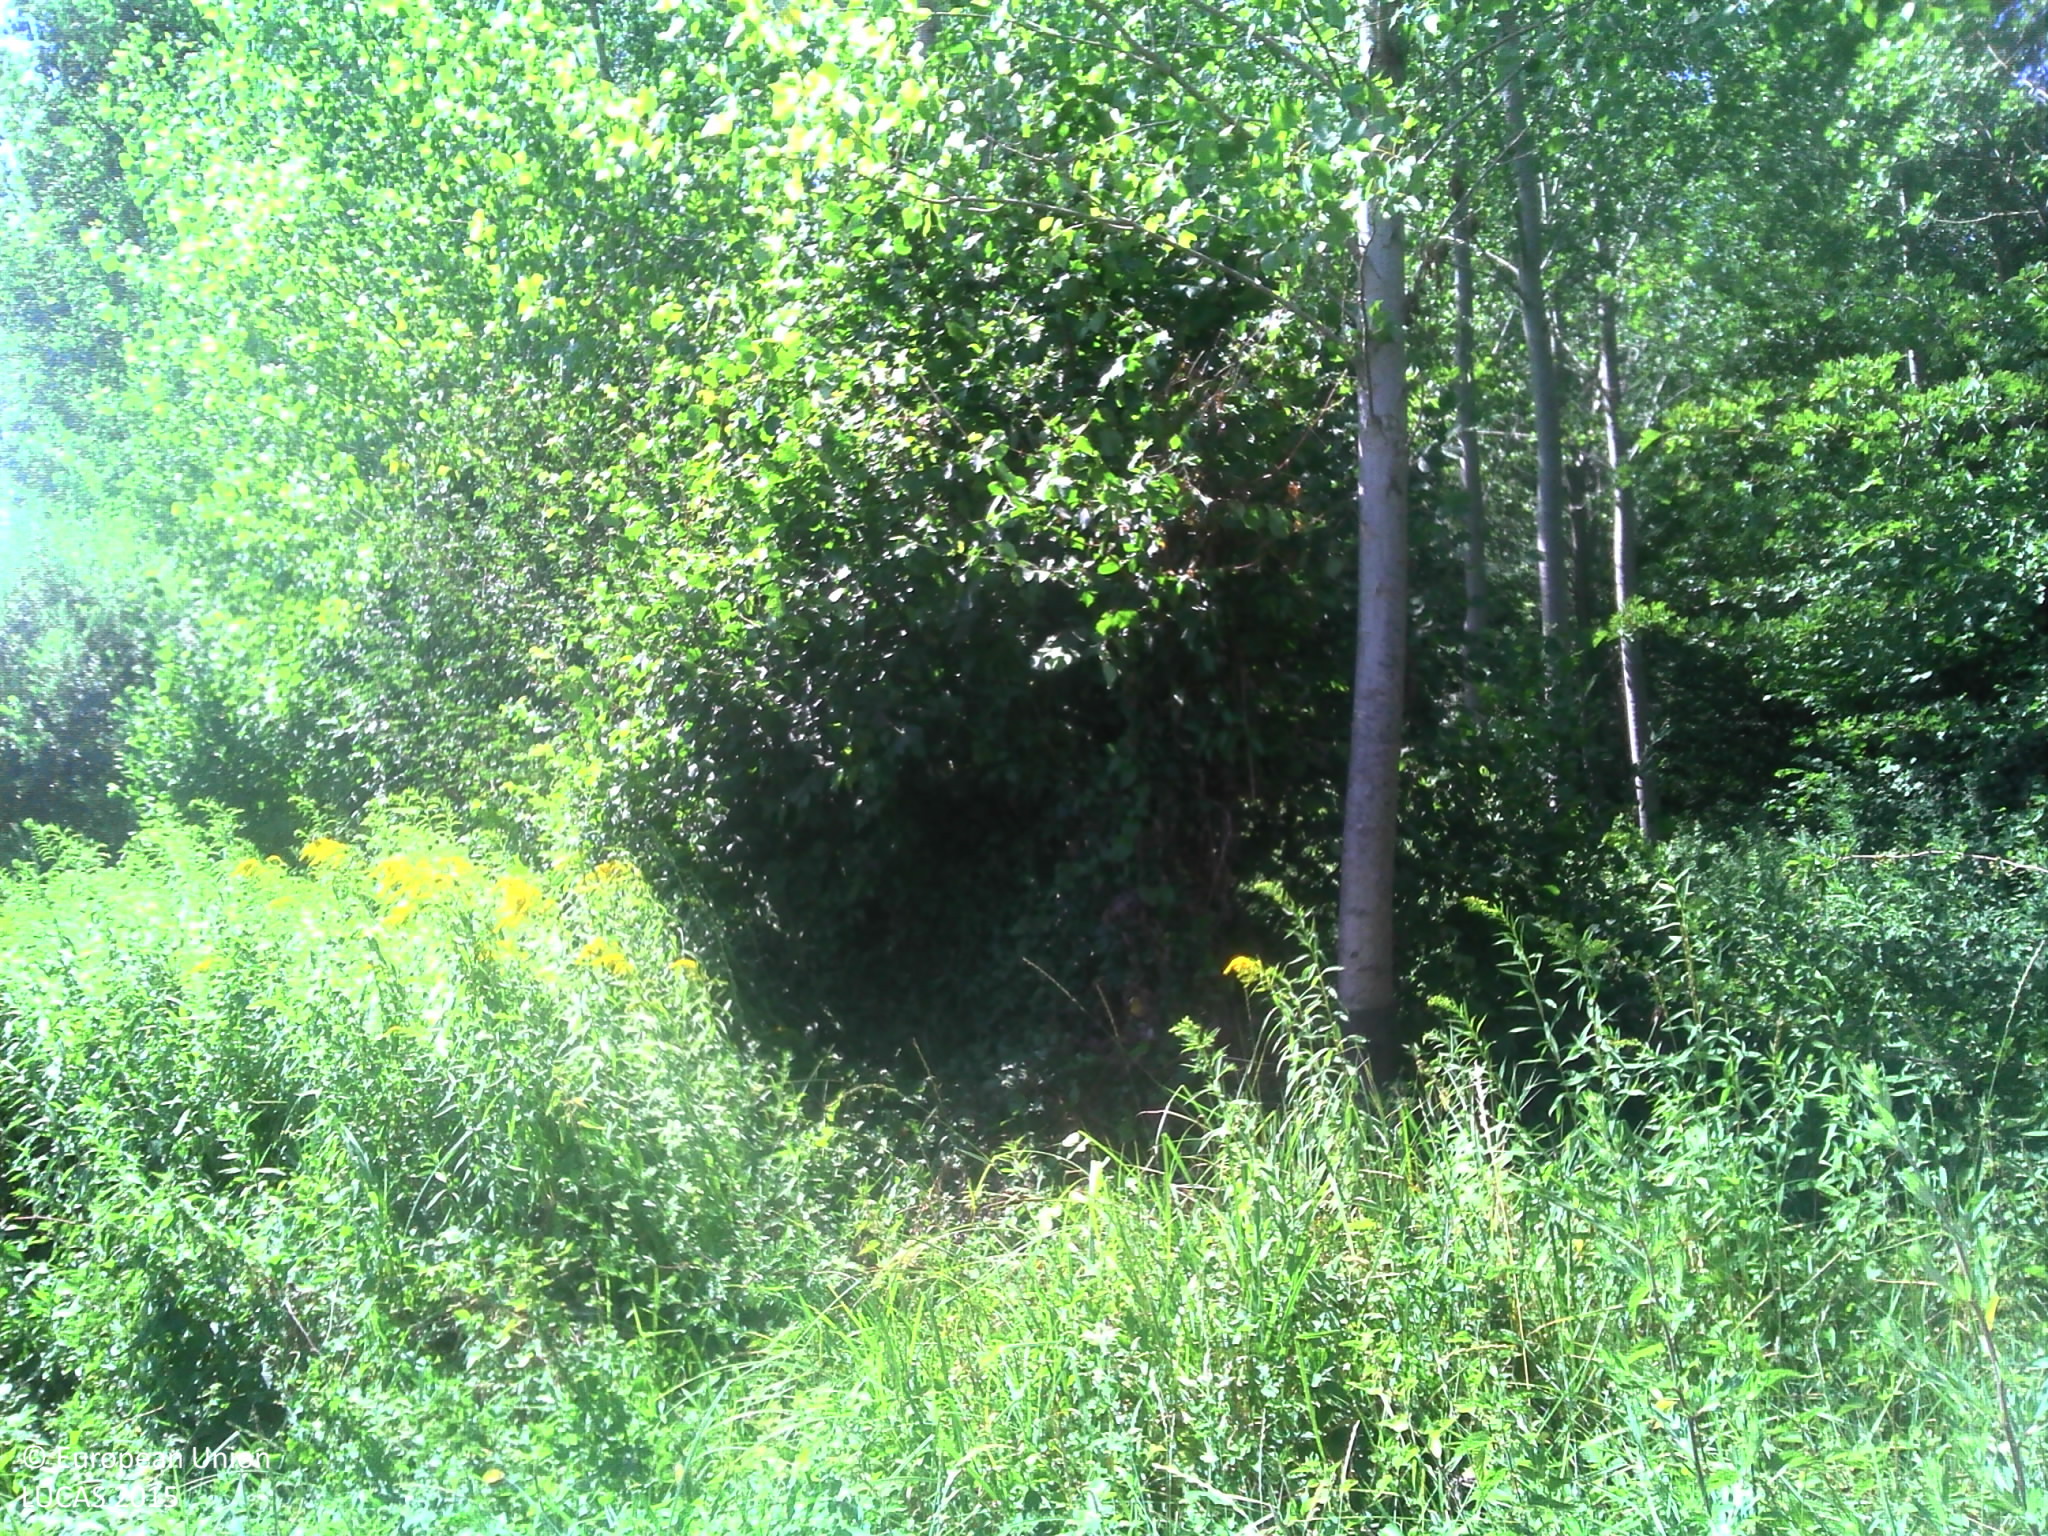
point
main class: Woodland
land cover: Broadleaved woodland
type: non-riverine alder, birch or aspen forest
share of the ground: > 75 %
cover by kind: broadleaved forest trees 75 %, herbaceous plants 25 %
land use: Forestry
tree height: > 5 m
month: July
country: FR
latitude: 45.5818
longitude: 4.9417
